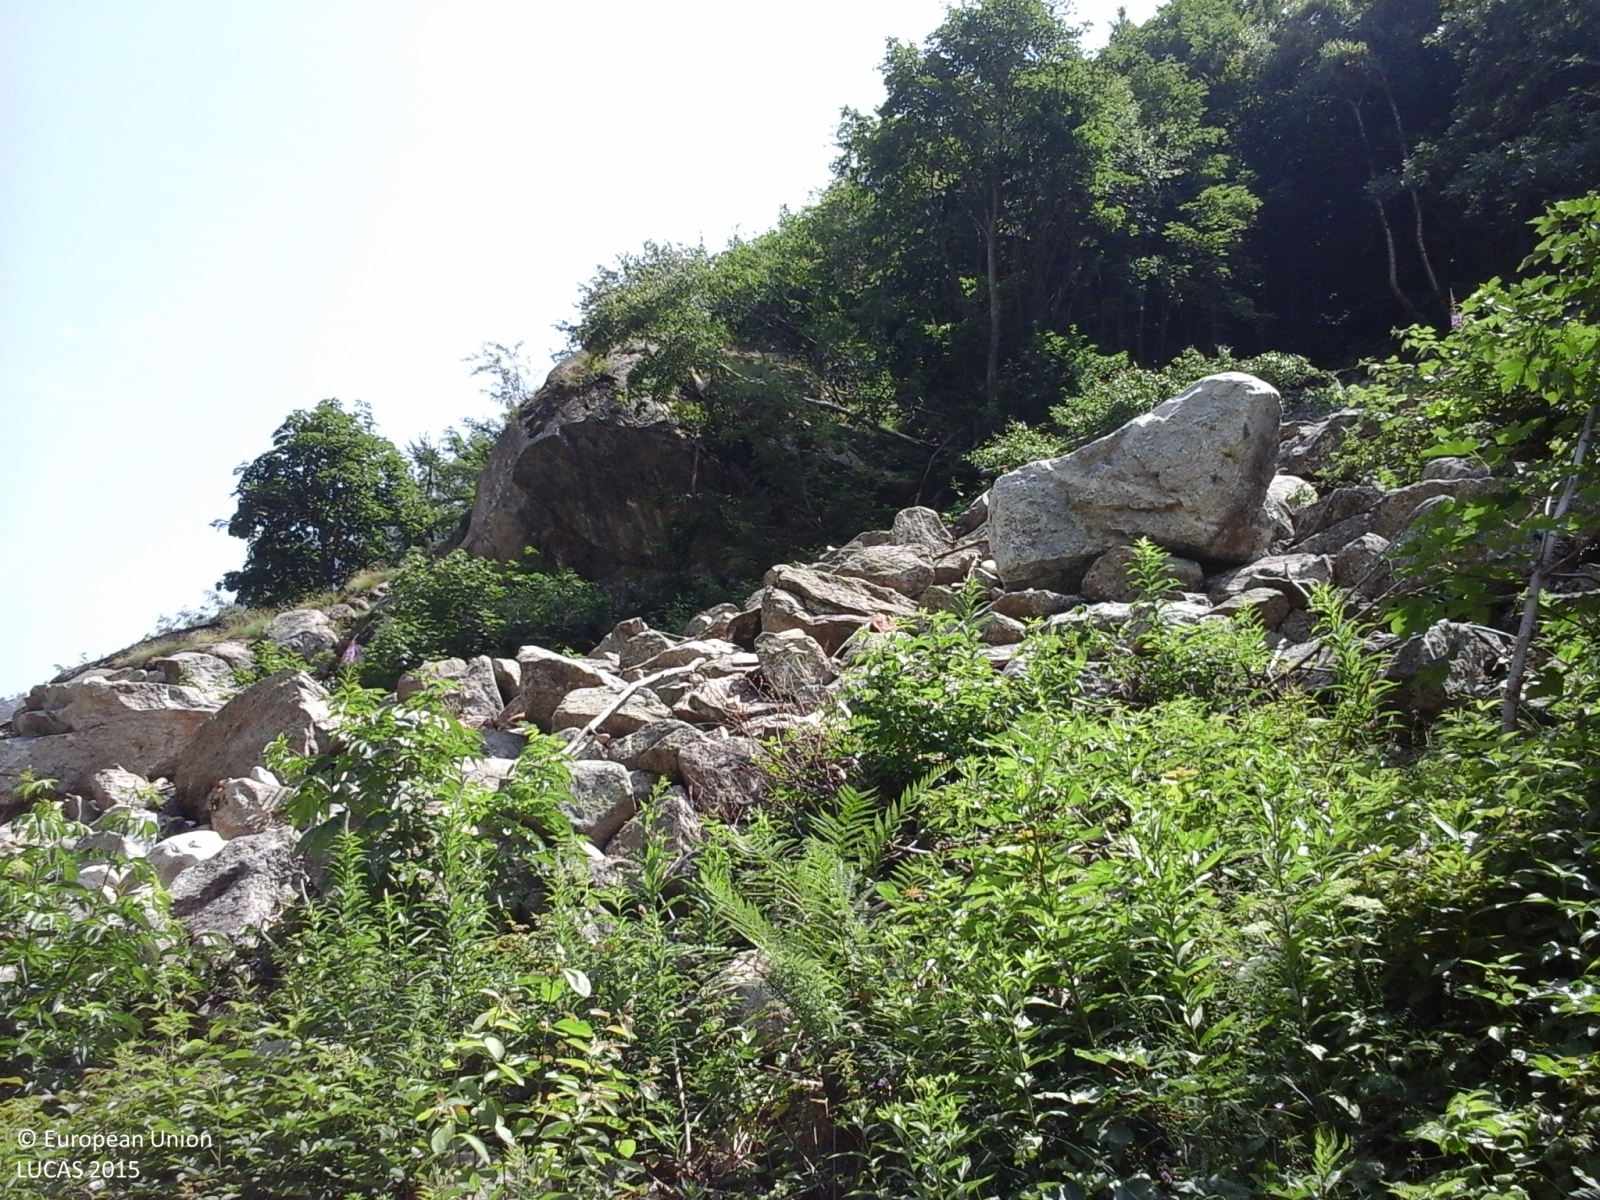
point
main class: Woodland
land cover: Other mixed woodland
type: mesophytic deciduous forest
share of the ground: > 75 %
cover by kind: broadleaved forest trees 70 %, coniferous forest trees 30 %
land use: Semi-natural and natural areas not in use
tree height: > 5 m
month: July
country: IT
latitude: 44.2750
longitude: 7.1369
